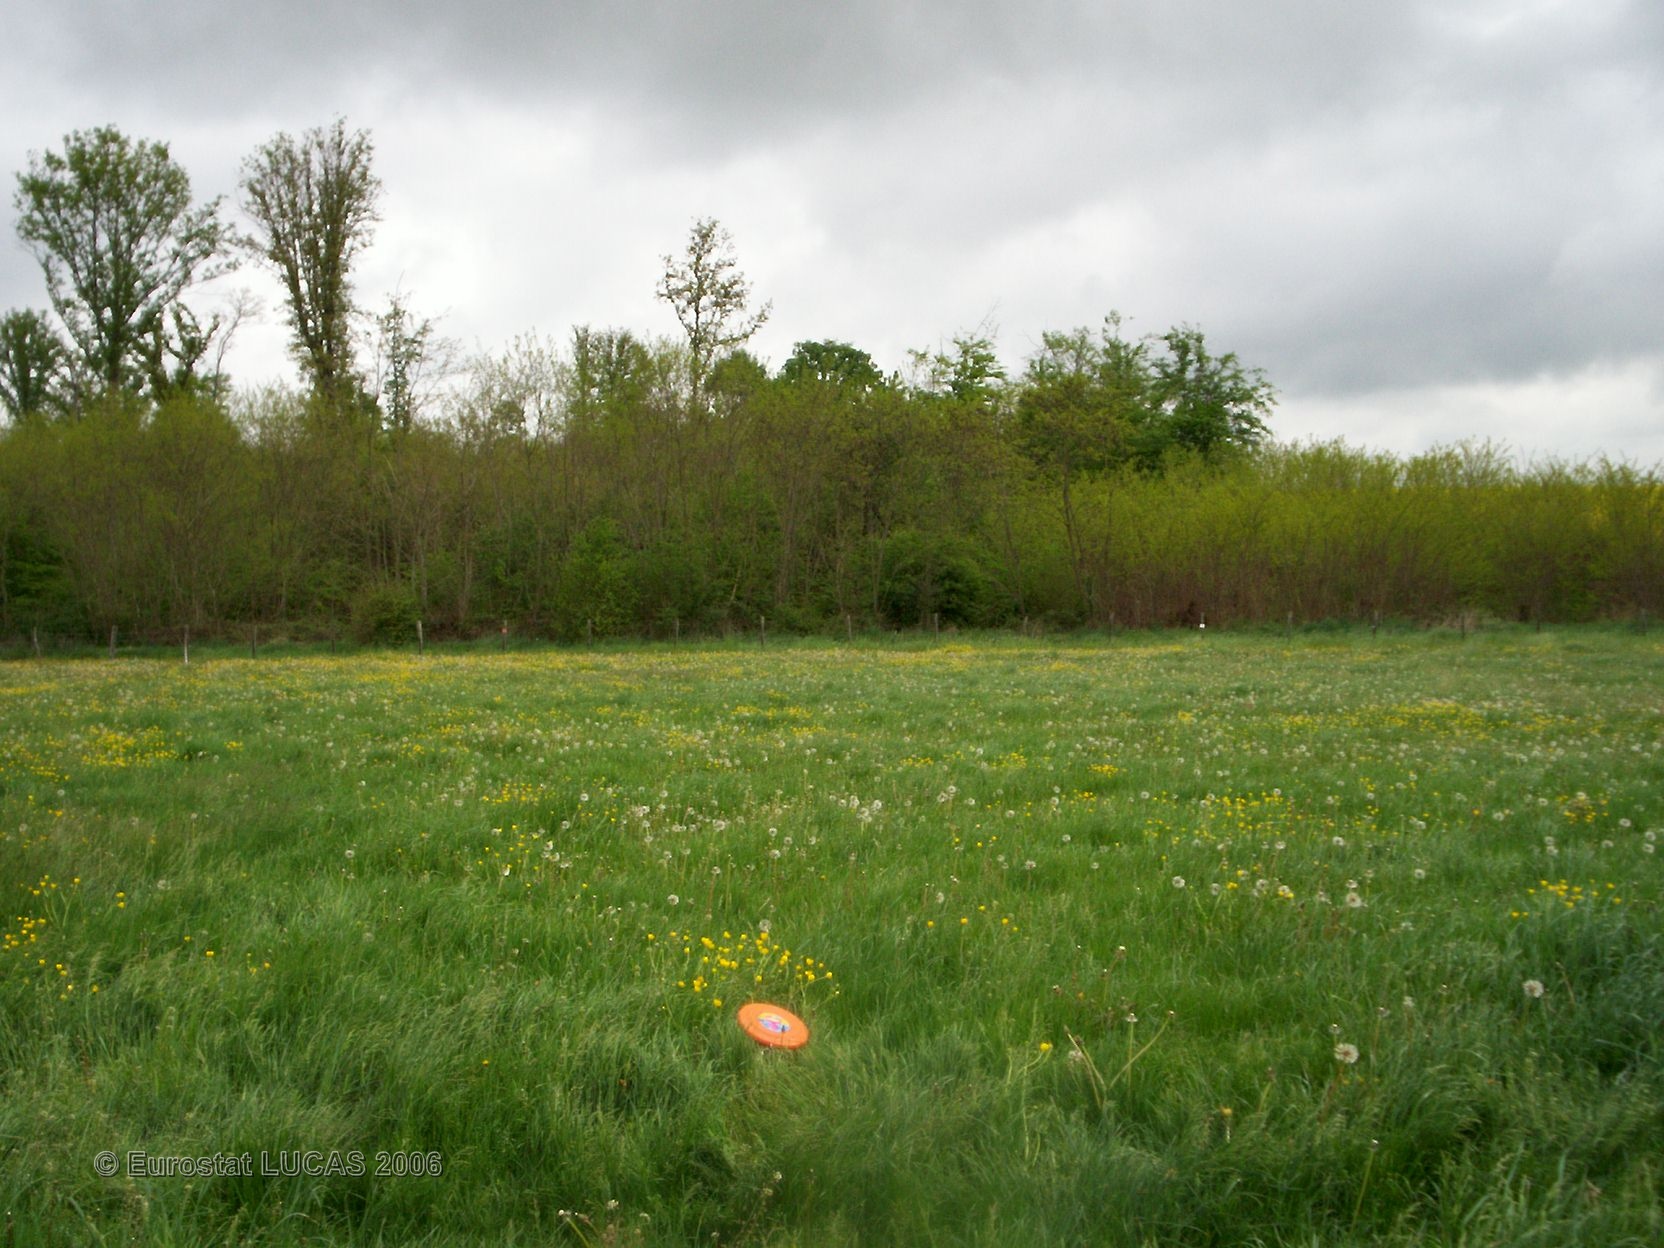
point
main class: Grassland
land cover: Grassland without tree/shrub cover
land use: Agriculture (excluding fallow land and kitchen gardens)
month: May
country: FR
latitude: 48.0144
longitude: 2.9275
